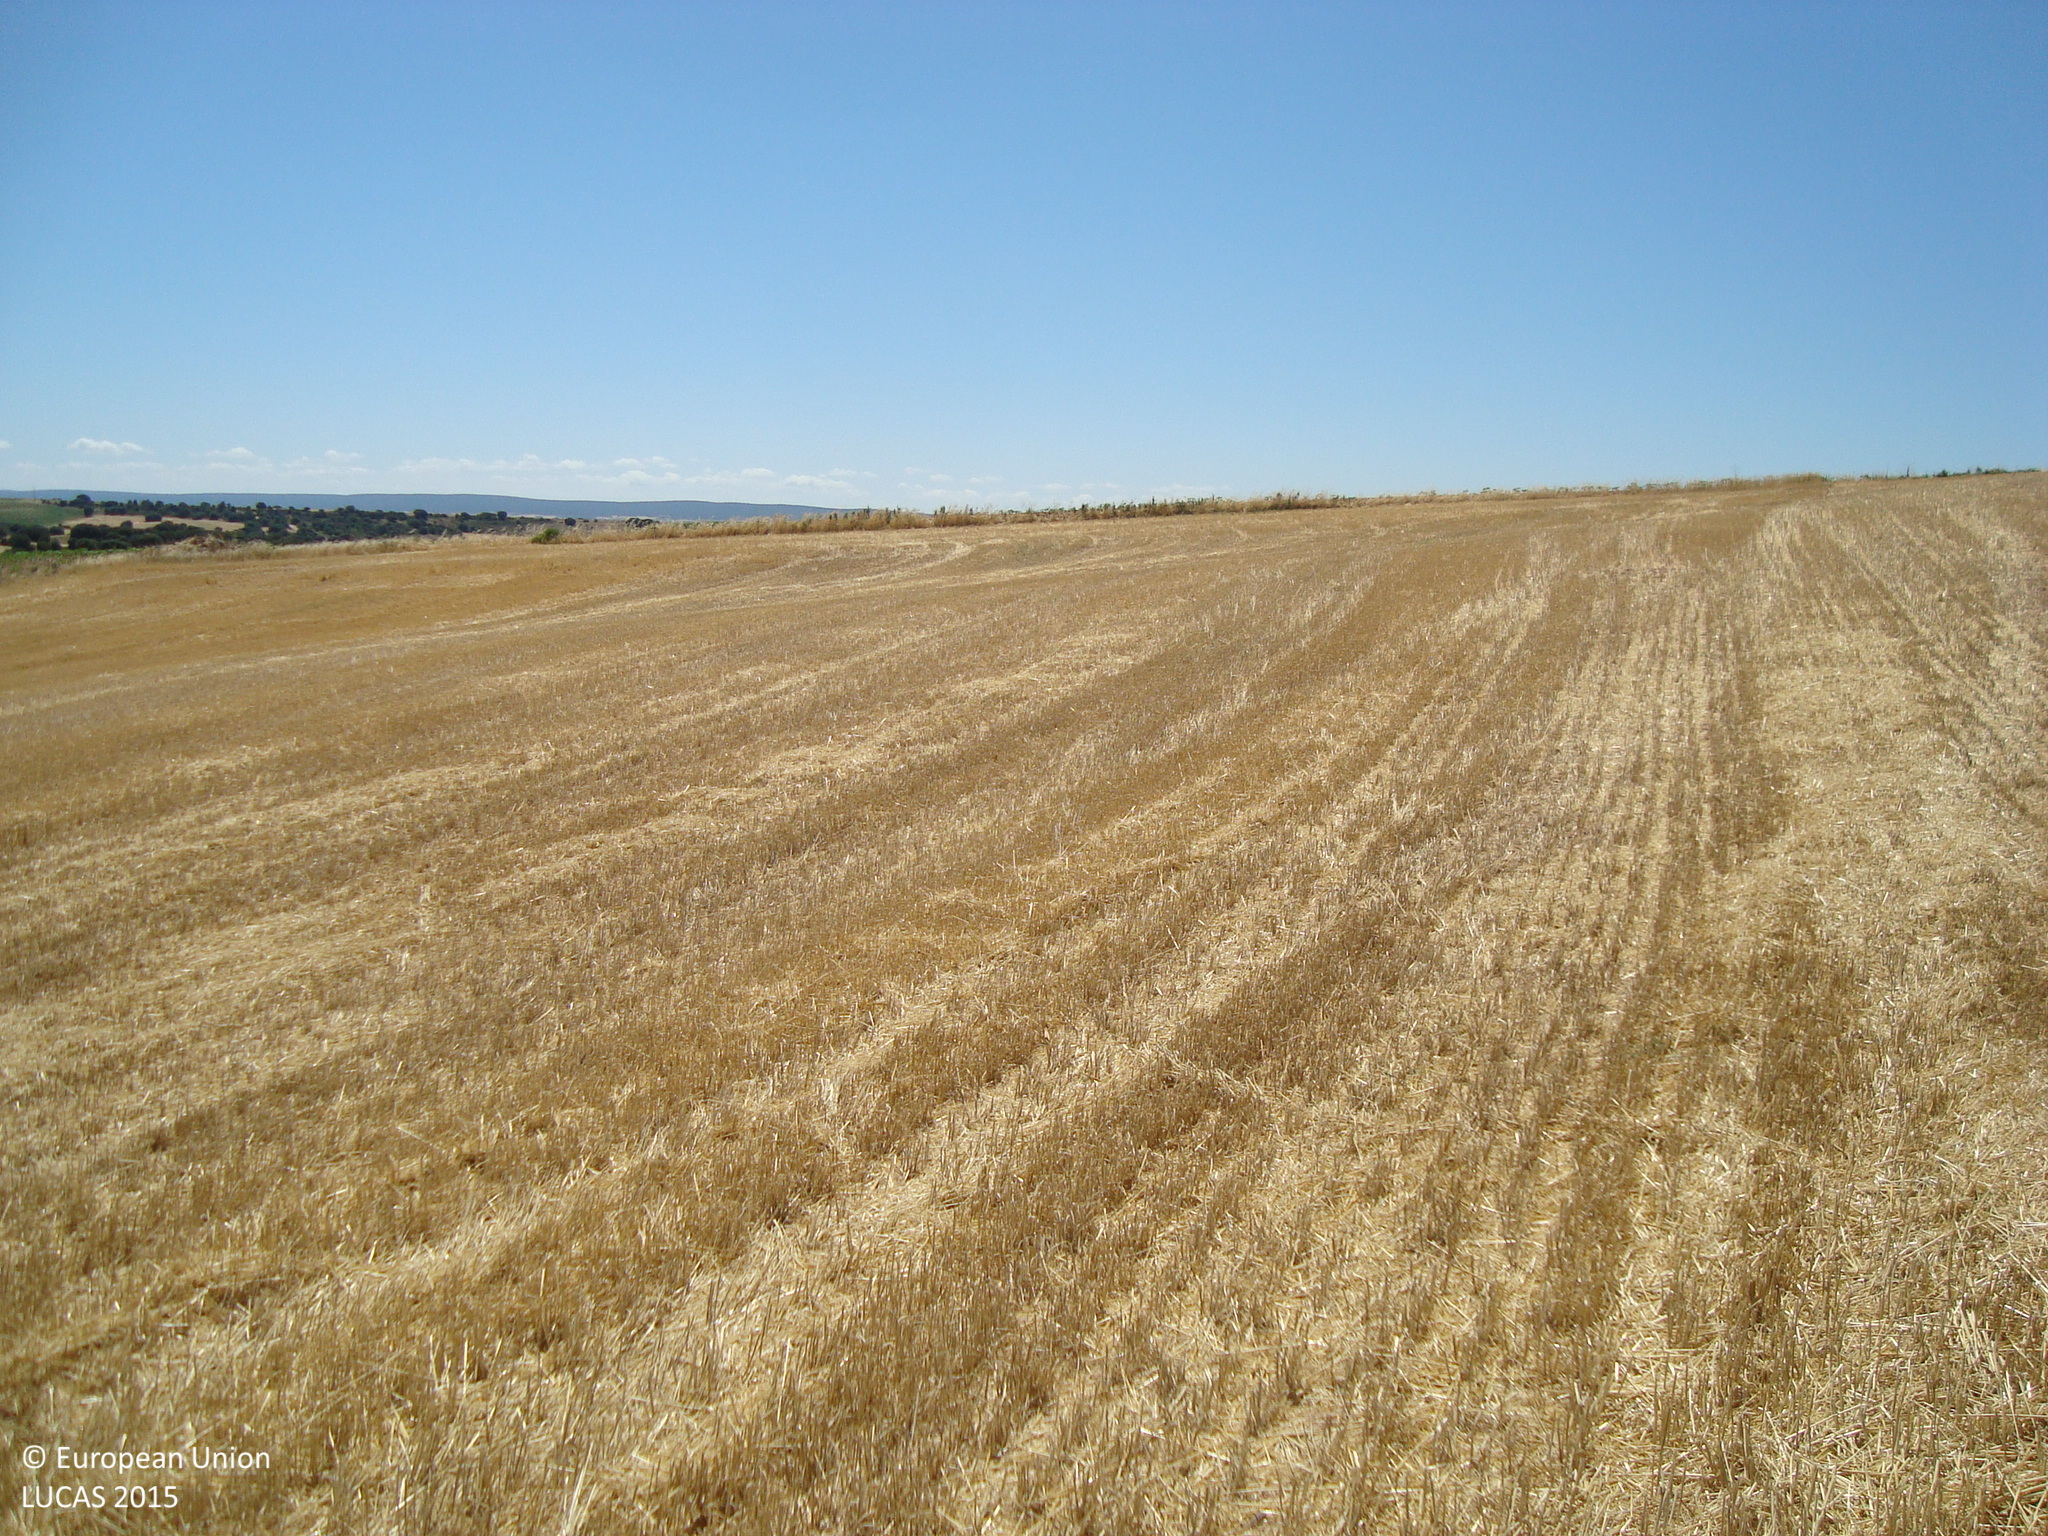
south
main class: Cropland
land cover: Common wheat
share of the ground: > 75 %
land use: Agriculture (excluding fallow land and kitchen gardens)
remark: Harvested field
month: July
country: ES
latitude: 42.0701
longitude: -3.8009
